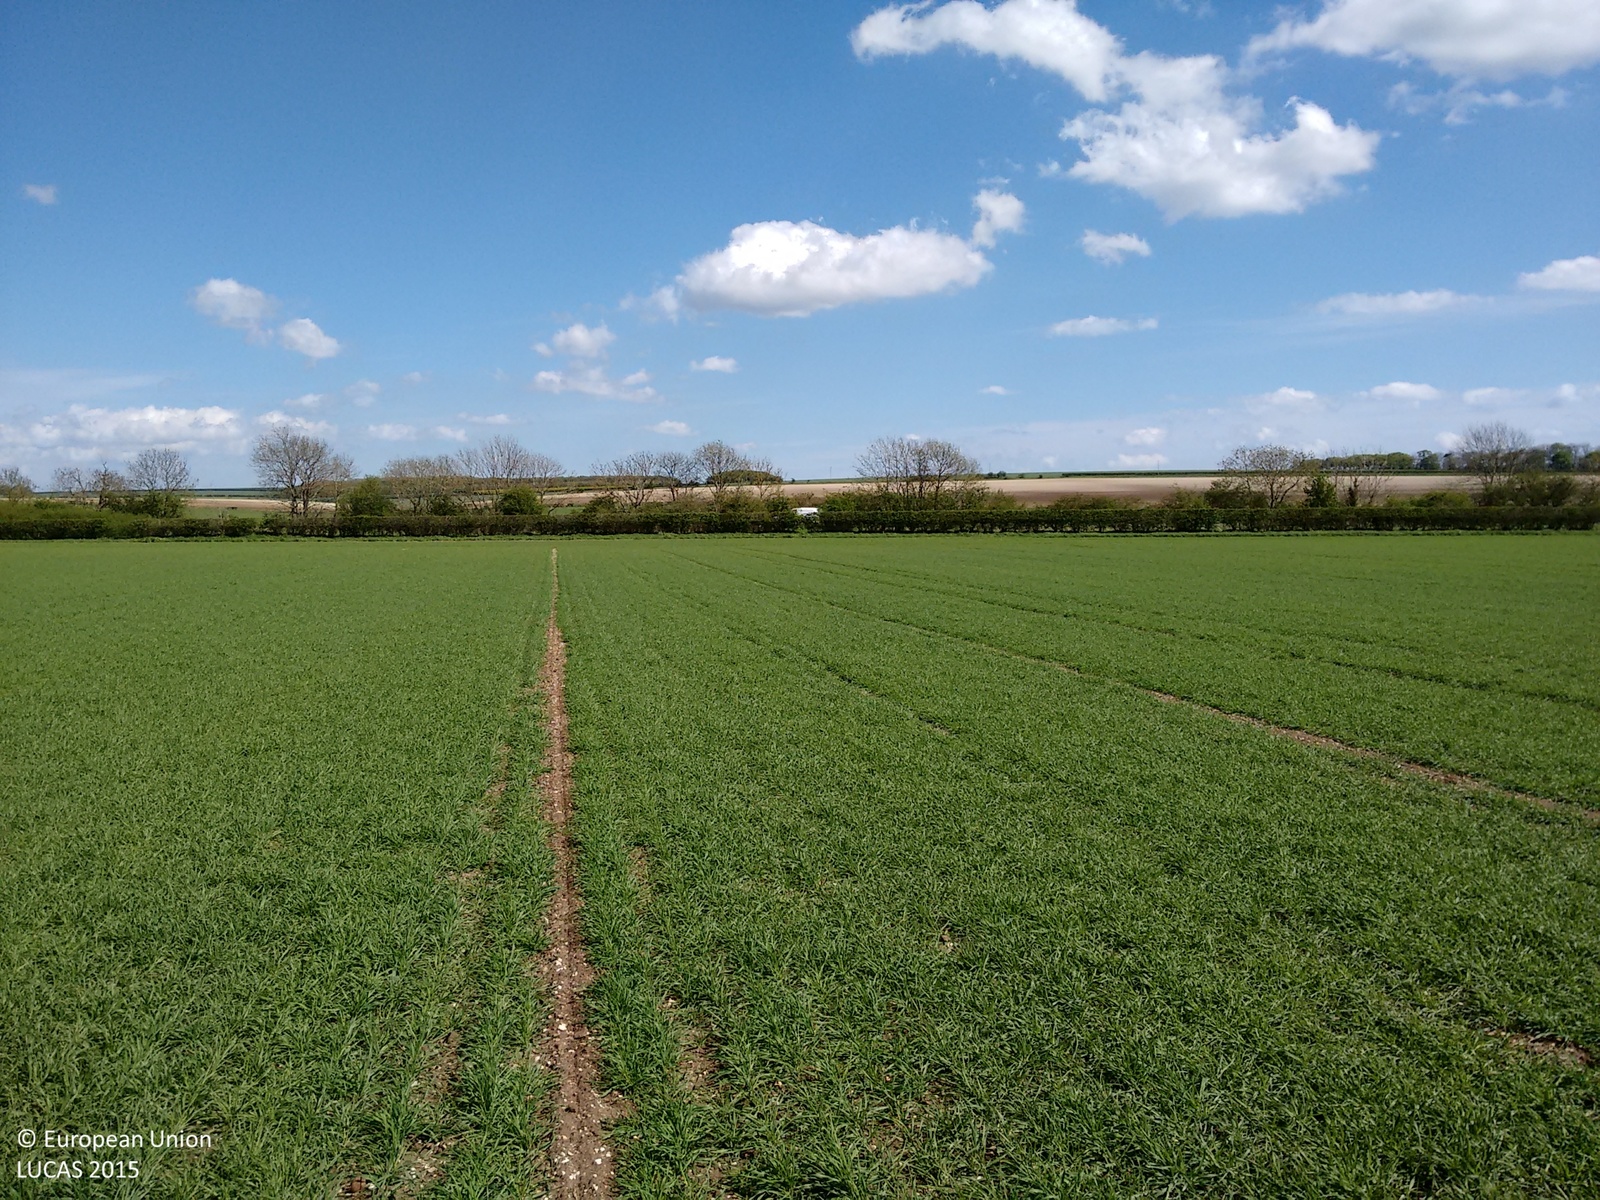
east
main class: Cropland
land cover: Barley
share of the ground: > 75 %
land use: Agriculture (excluding fallow land and kitchen gardens)
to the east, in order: Barley; Grass margins; Managed hedges; Grassland without tree/shrub cover; Paved roads, cycling and walking lanes; Grass margins; Managed hedges; Permanent crops (only in case pi)
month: May
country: GB
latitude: 54.1015
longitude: -0.3265
